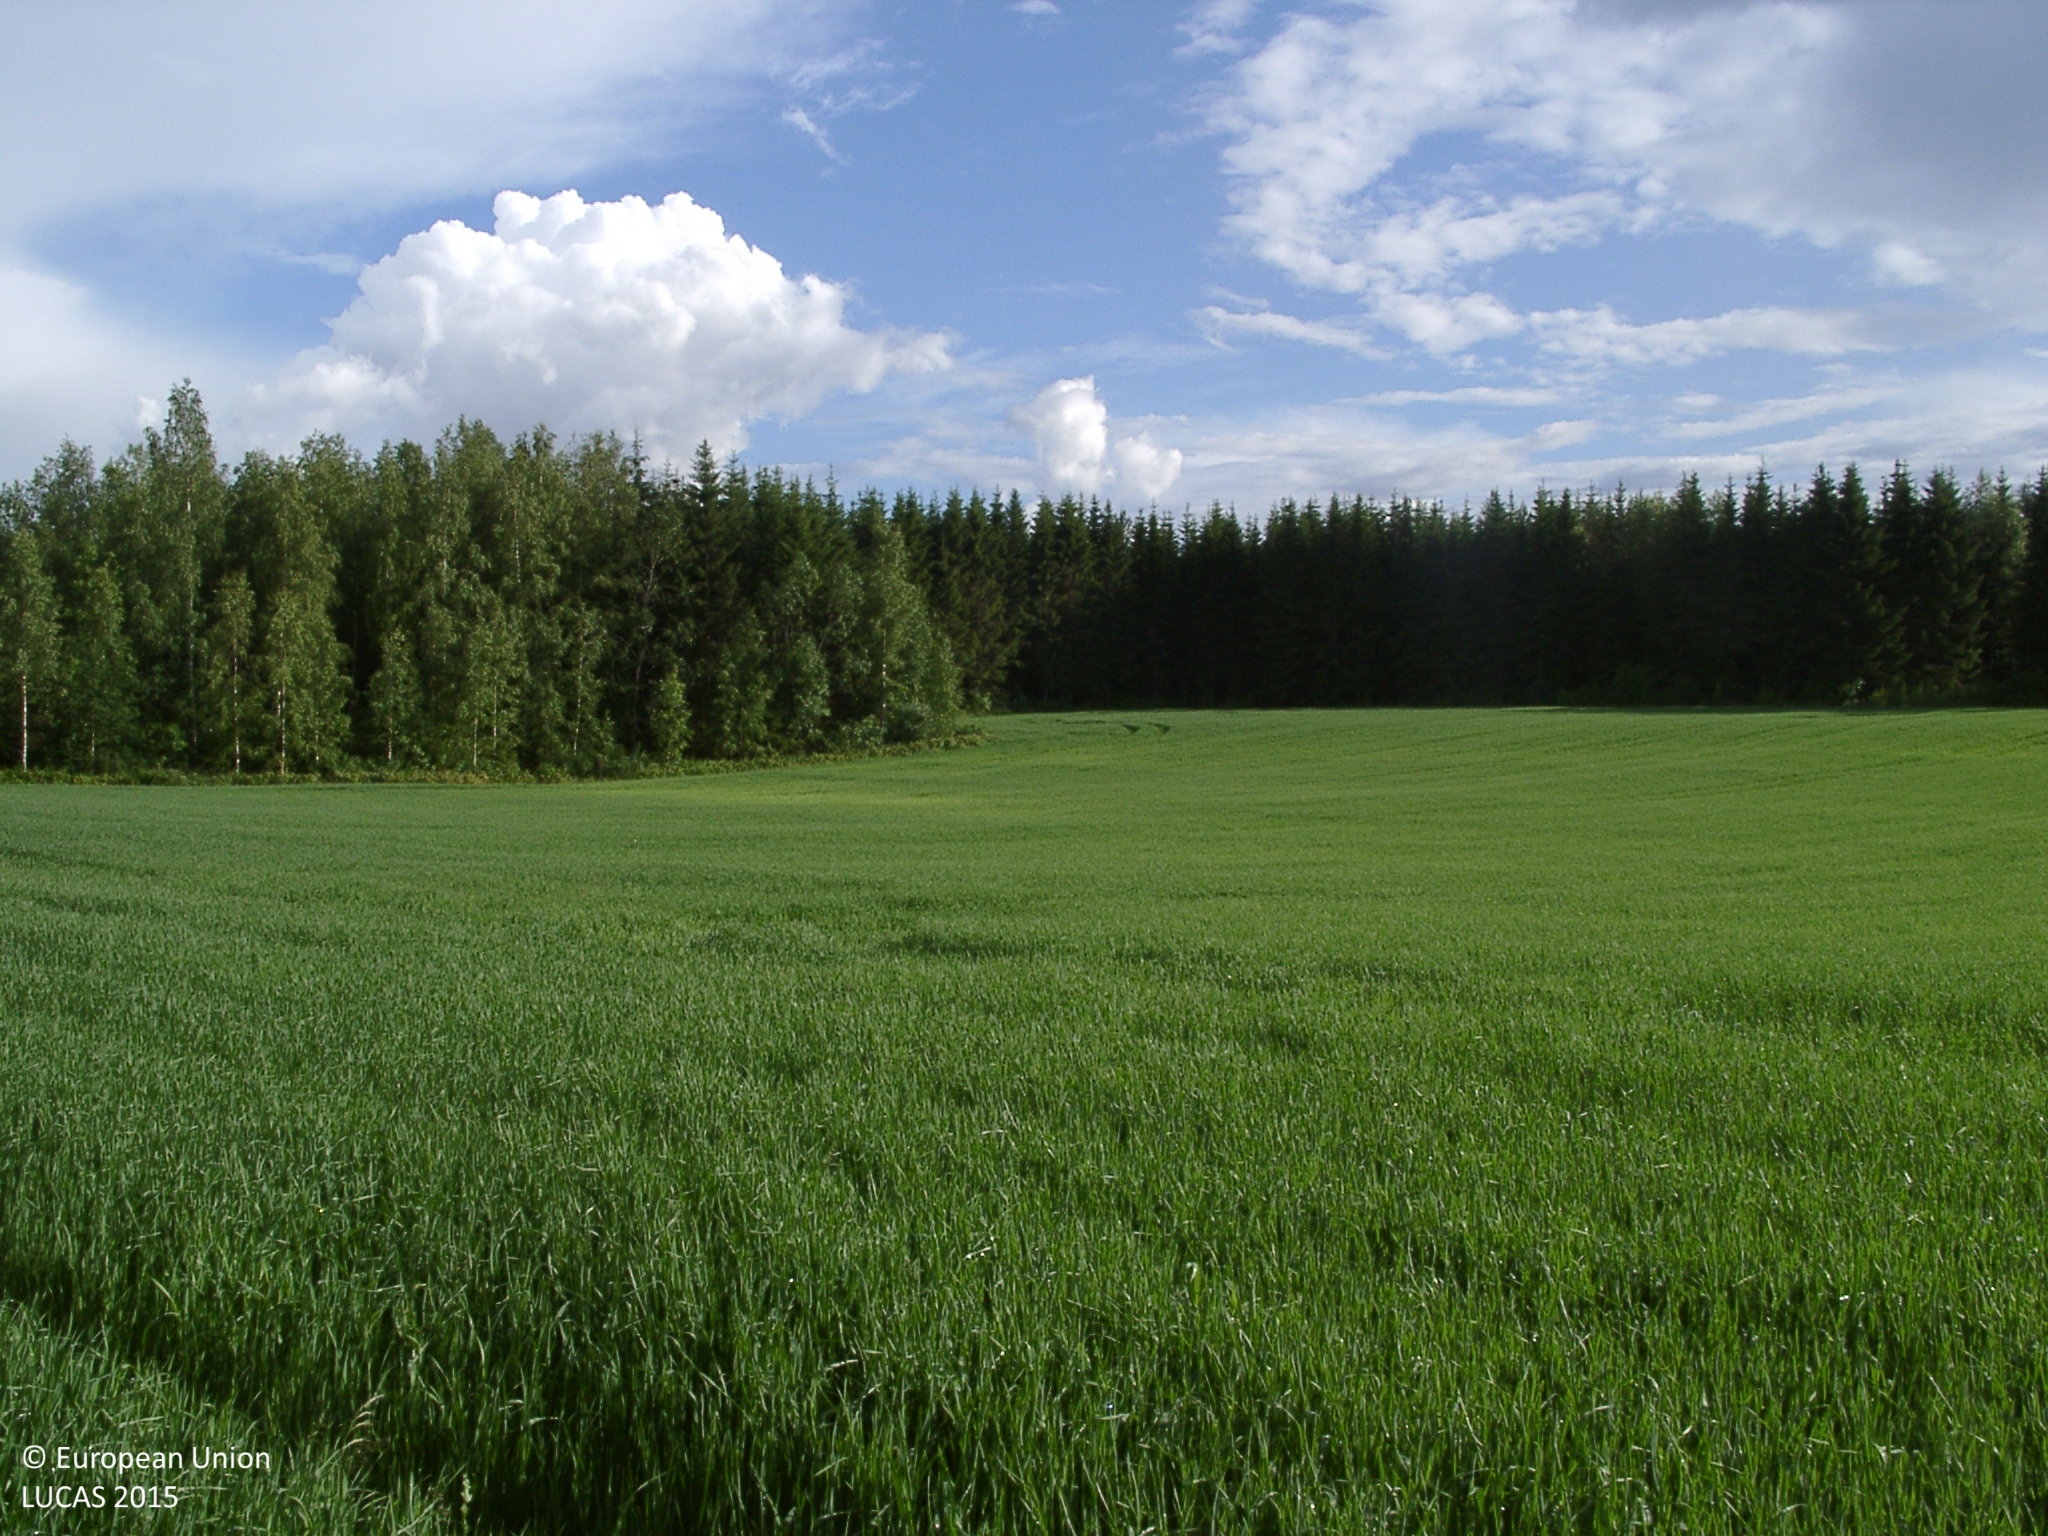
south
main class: Cropland
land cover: Oats
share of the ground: > 75 %
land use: Agriculture (excluding fallow land and kitchen gardens)
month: July
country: FI
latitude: 62.2028
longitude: 25.1965
